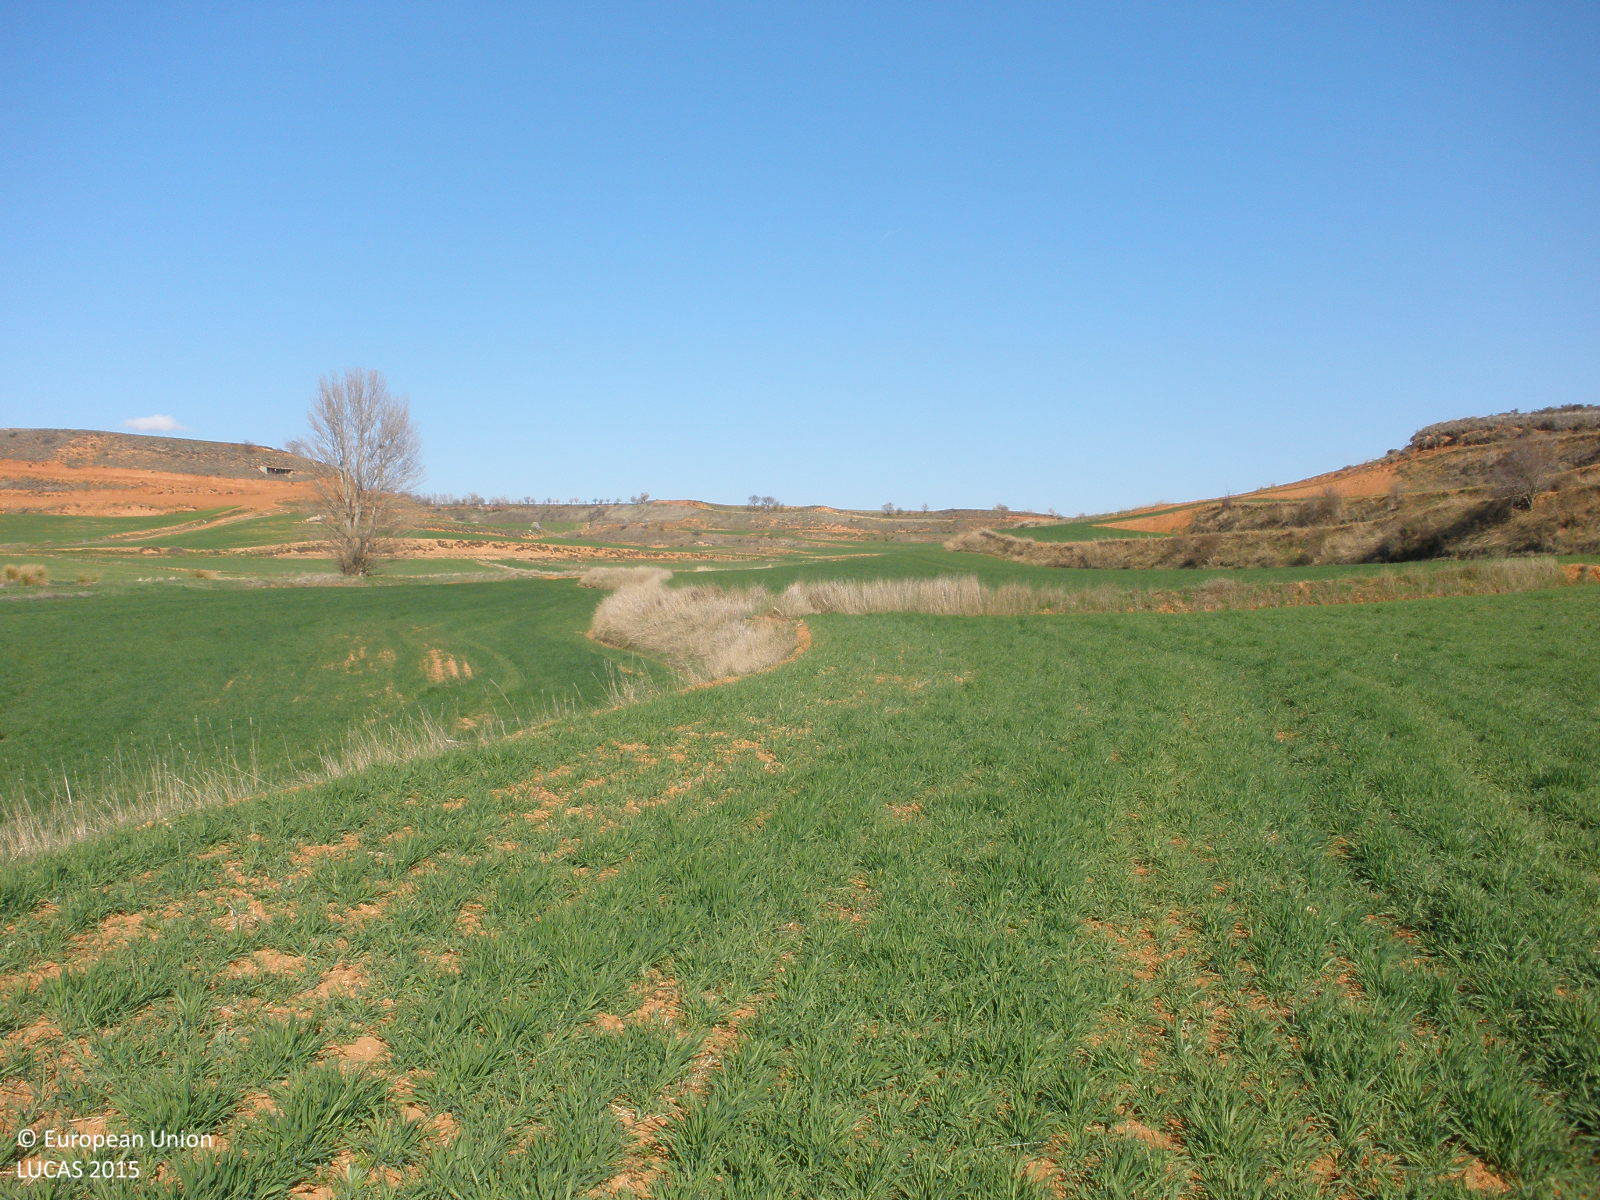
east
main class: Cropland
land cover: Barley
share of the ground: > 75 %
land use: Agriculture (excluding fallow land and kitchen gardens)
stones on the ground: < 10 %
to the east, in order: Barley; Grass margins; Barley; Grass margins; Barley; Grass margins; Rivers and streams; Grass margins; Barley
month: April
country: ES
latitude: 40.9103
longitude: -1.1172
